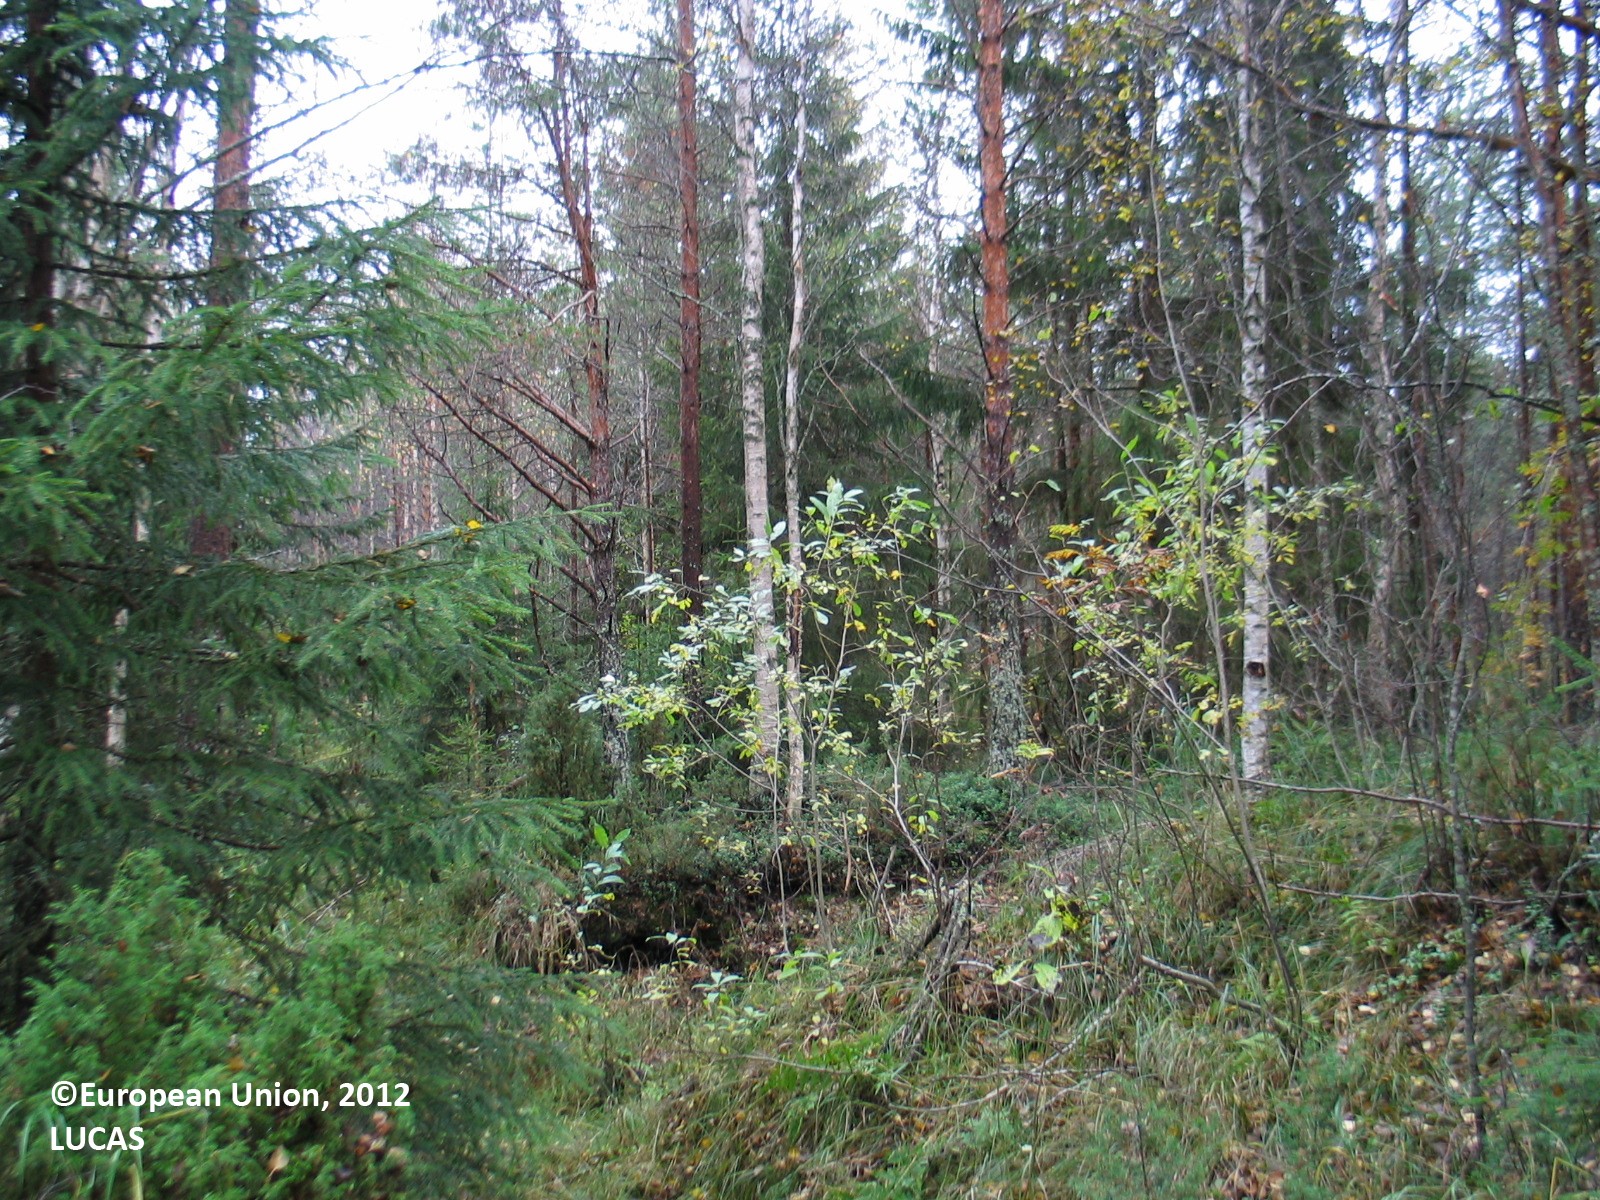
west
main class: Woodland
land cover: Other mixed woodland
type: boreal forest
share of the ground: 50 - 75 %
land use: Forestry
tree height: > 5 m
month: September
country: FI
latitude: 65.3513
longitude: 25.4868
